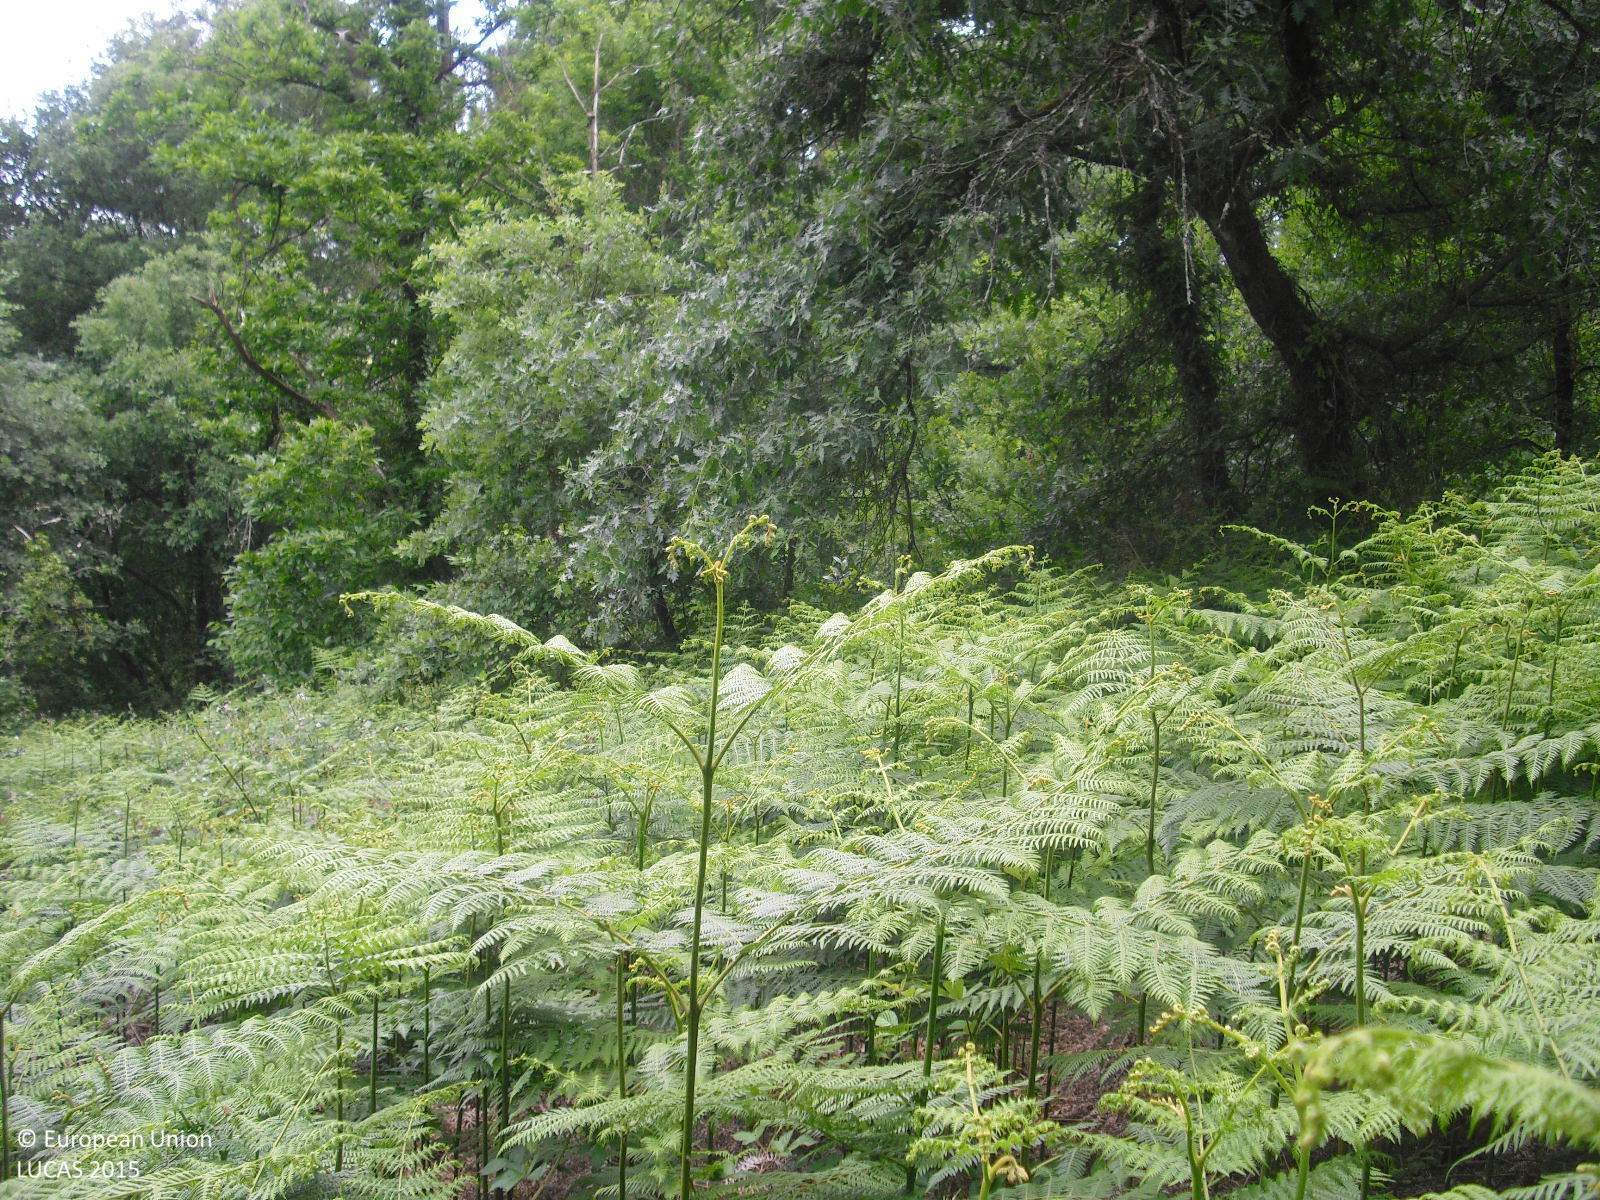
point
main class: Woodland
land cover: Broadleaved woodland
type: acidophilous oak and oak-birch forest
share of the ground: 25 - 50 %
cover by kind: shrubs 60 %, broadleaved forest trees 40 %
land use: Forestry
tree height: > 5 m
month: May
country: ES
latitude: 42.1992
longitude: -7.9406
